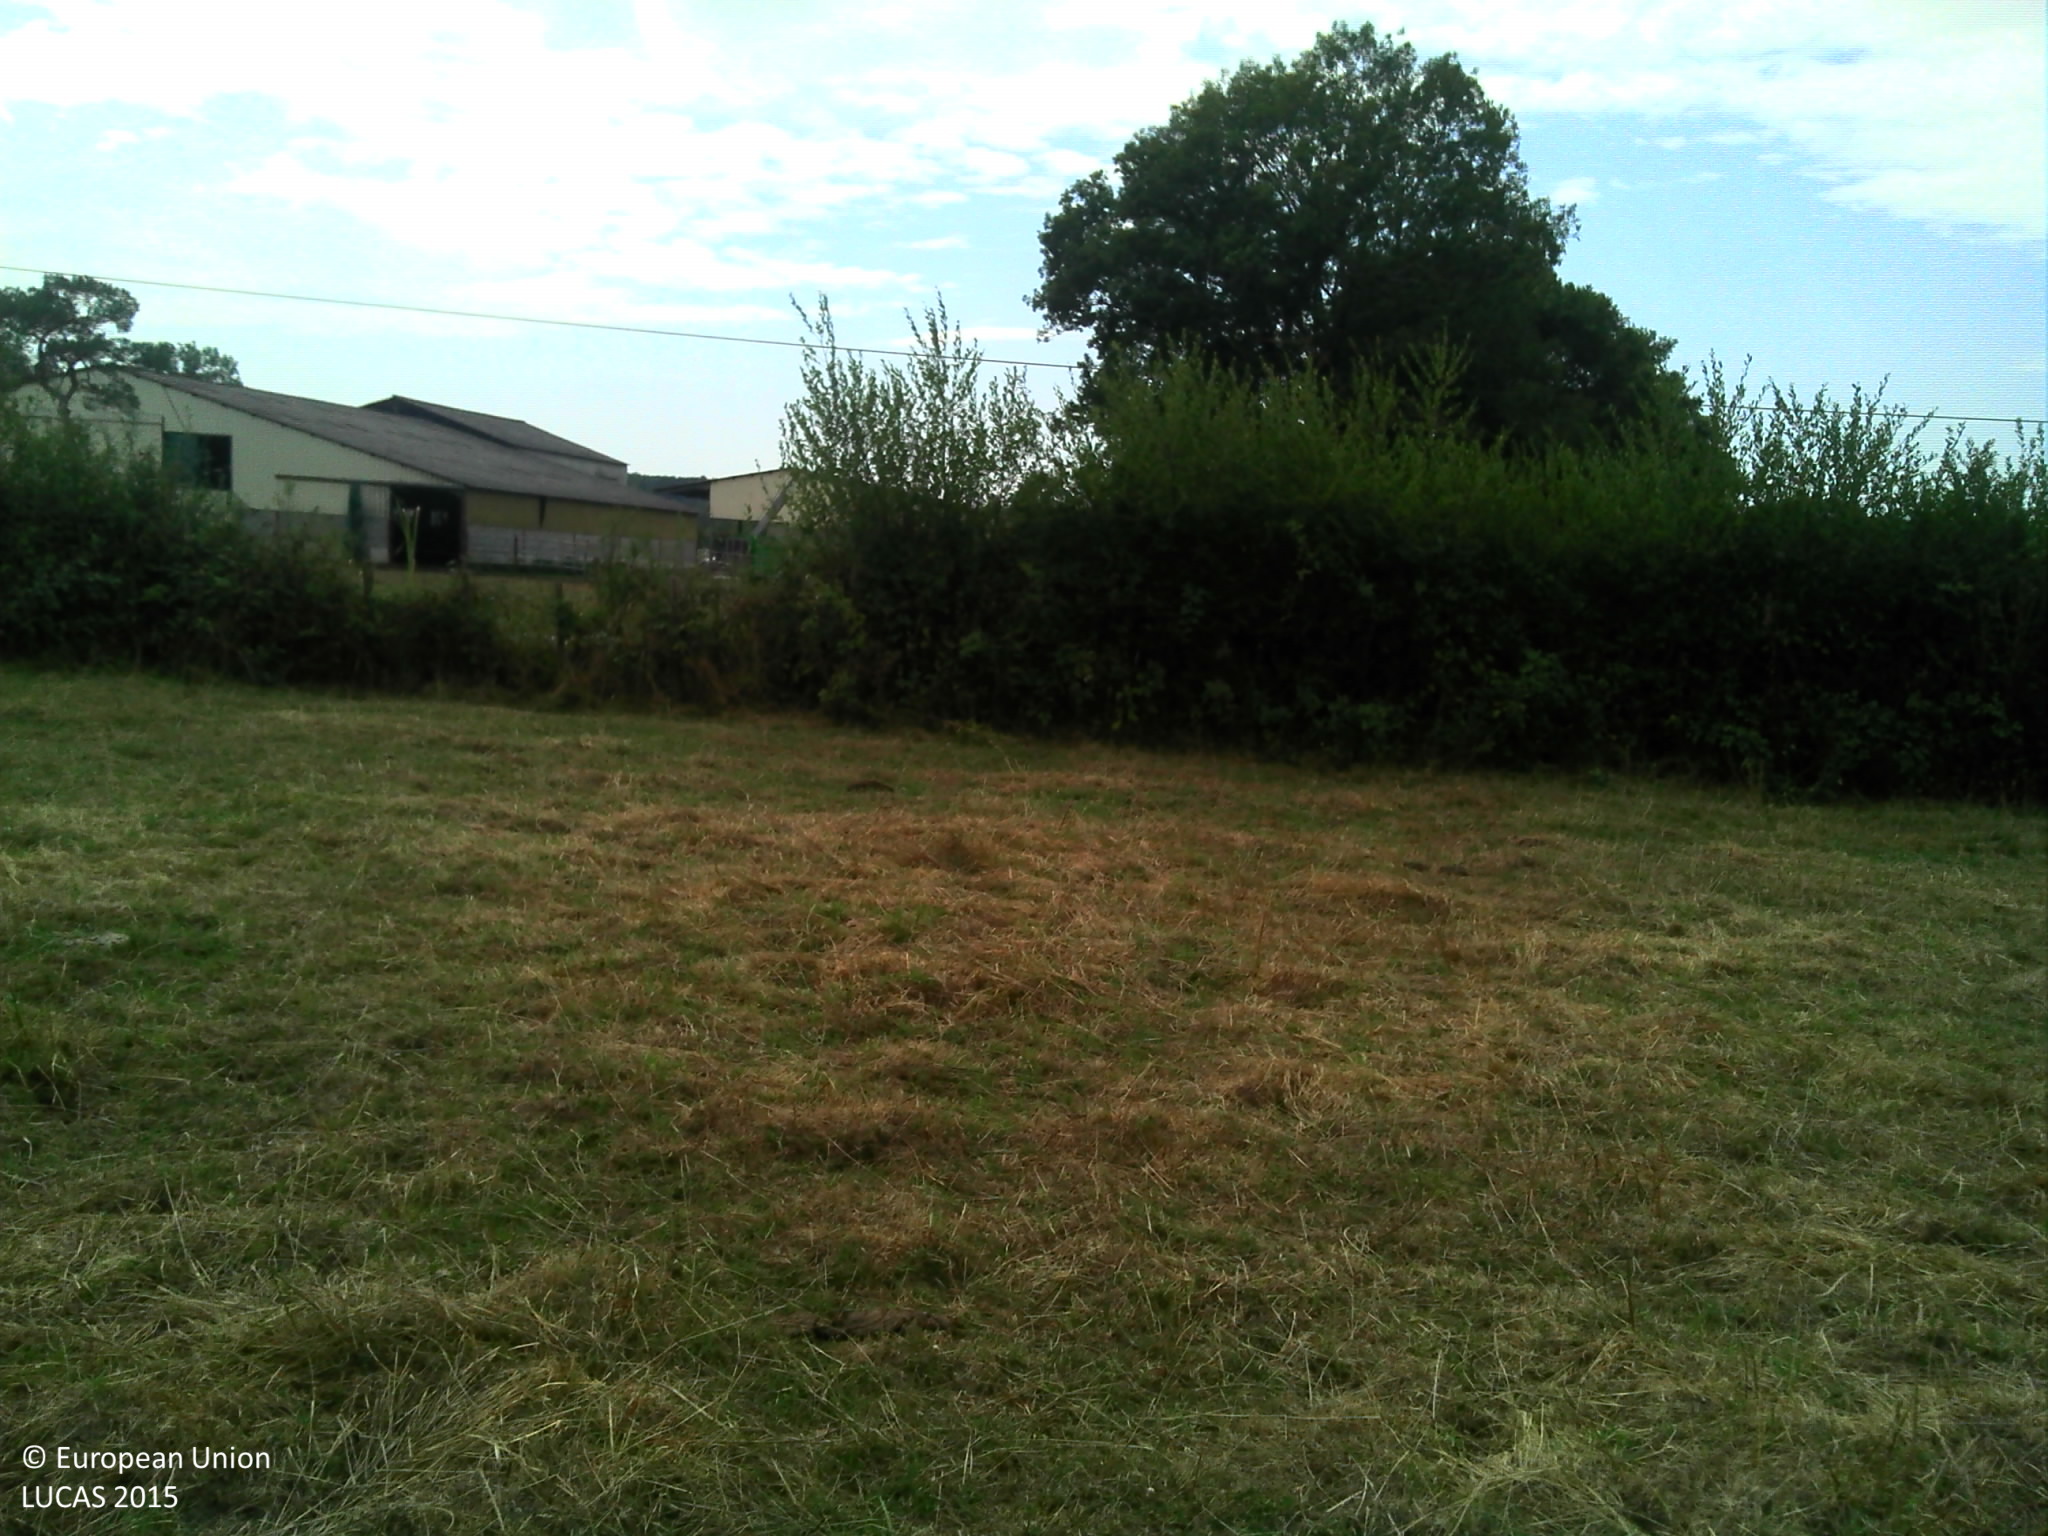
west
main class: Grassland
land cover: Grassland without tree/shrub cover
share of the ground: > 75 %
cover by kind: herbaceous plants 100 %
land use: Agriculture (excluding fallow land and kitchen gardens)
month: August
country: FR
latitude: 46.2696
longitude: 3.6289
